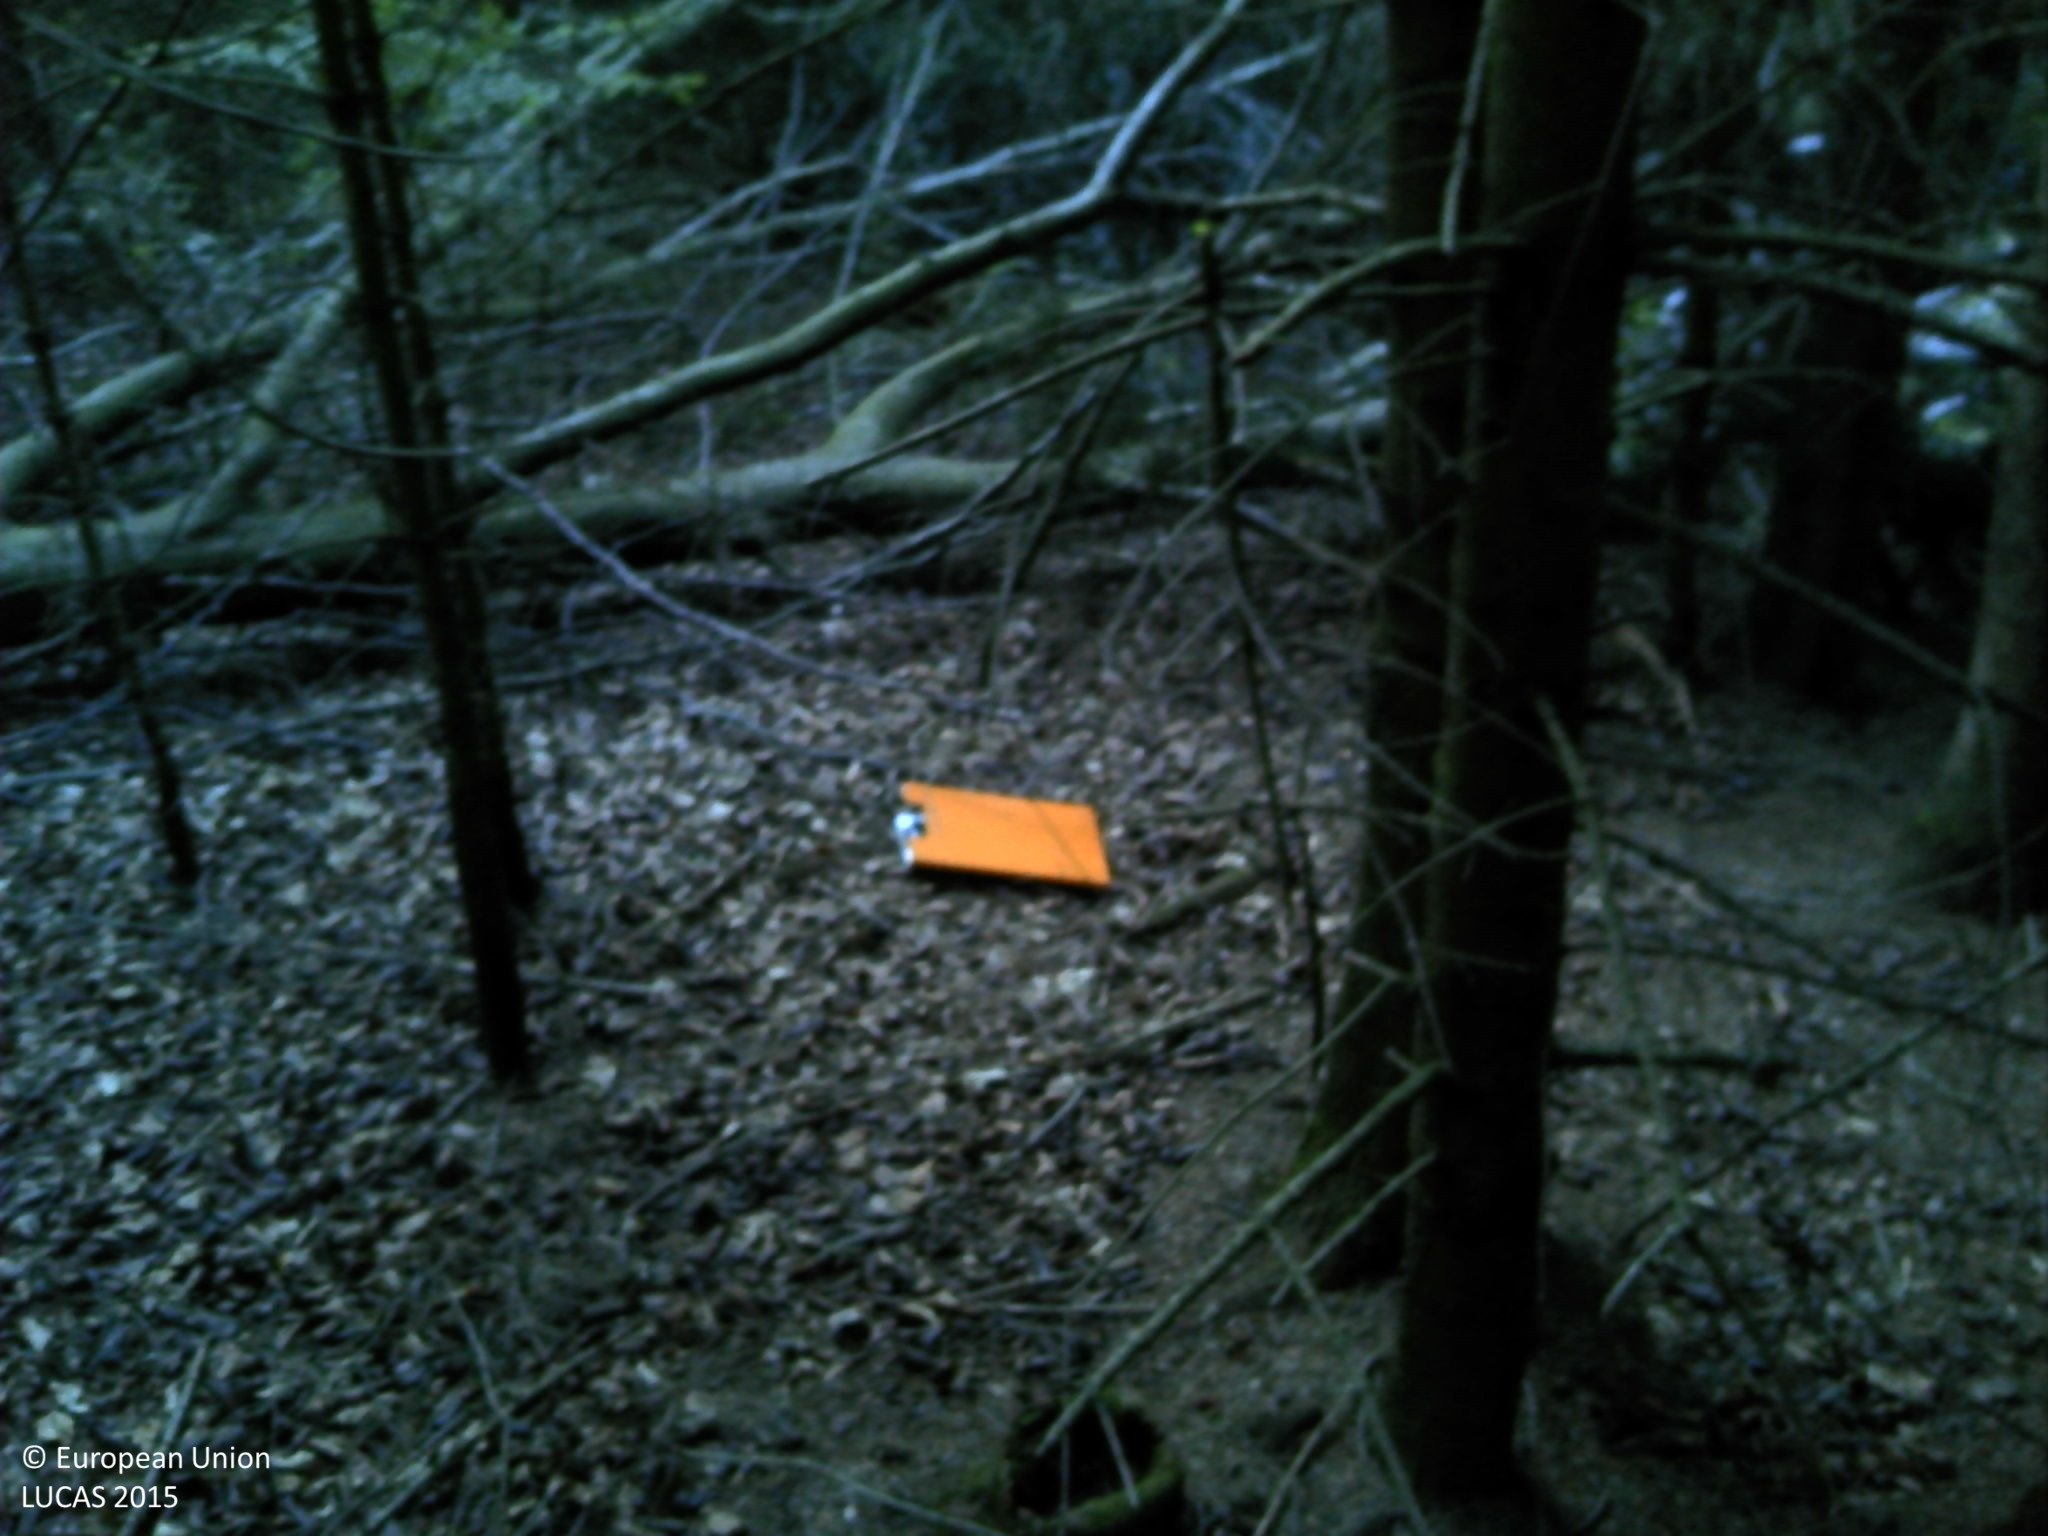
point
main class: Woodland
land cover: Spruce dominated mixed woodland
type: alpine coniferous forest
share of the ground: > 75 %
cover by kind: coniferous forest trees 60 %, broadleaved forest trees 35 %, unconsolidated bare surface 5 %
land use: Forestry
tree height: > 5 m
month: August
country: FR
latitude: 48.2869
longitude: 6.8606
